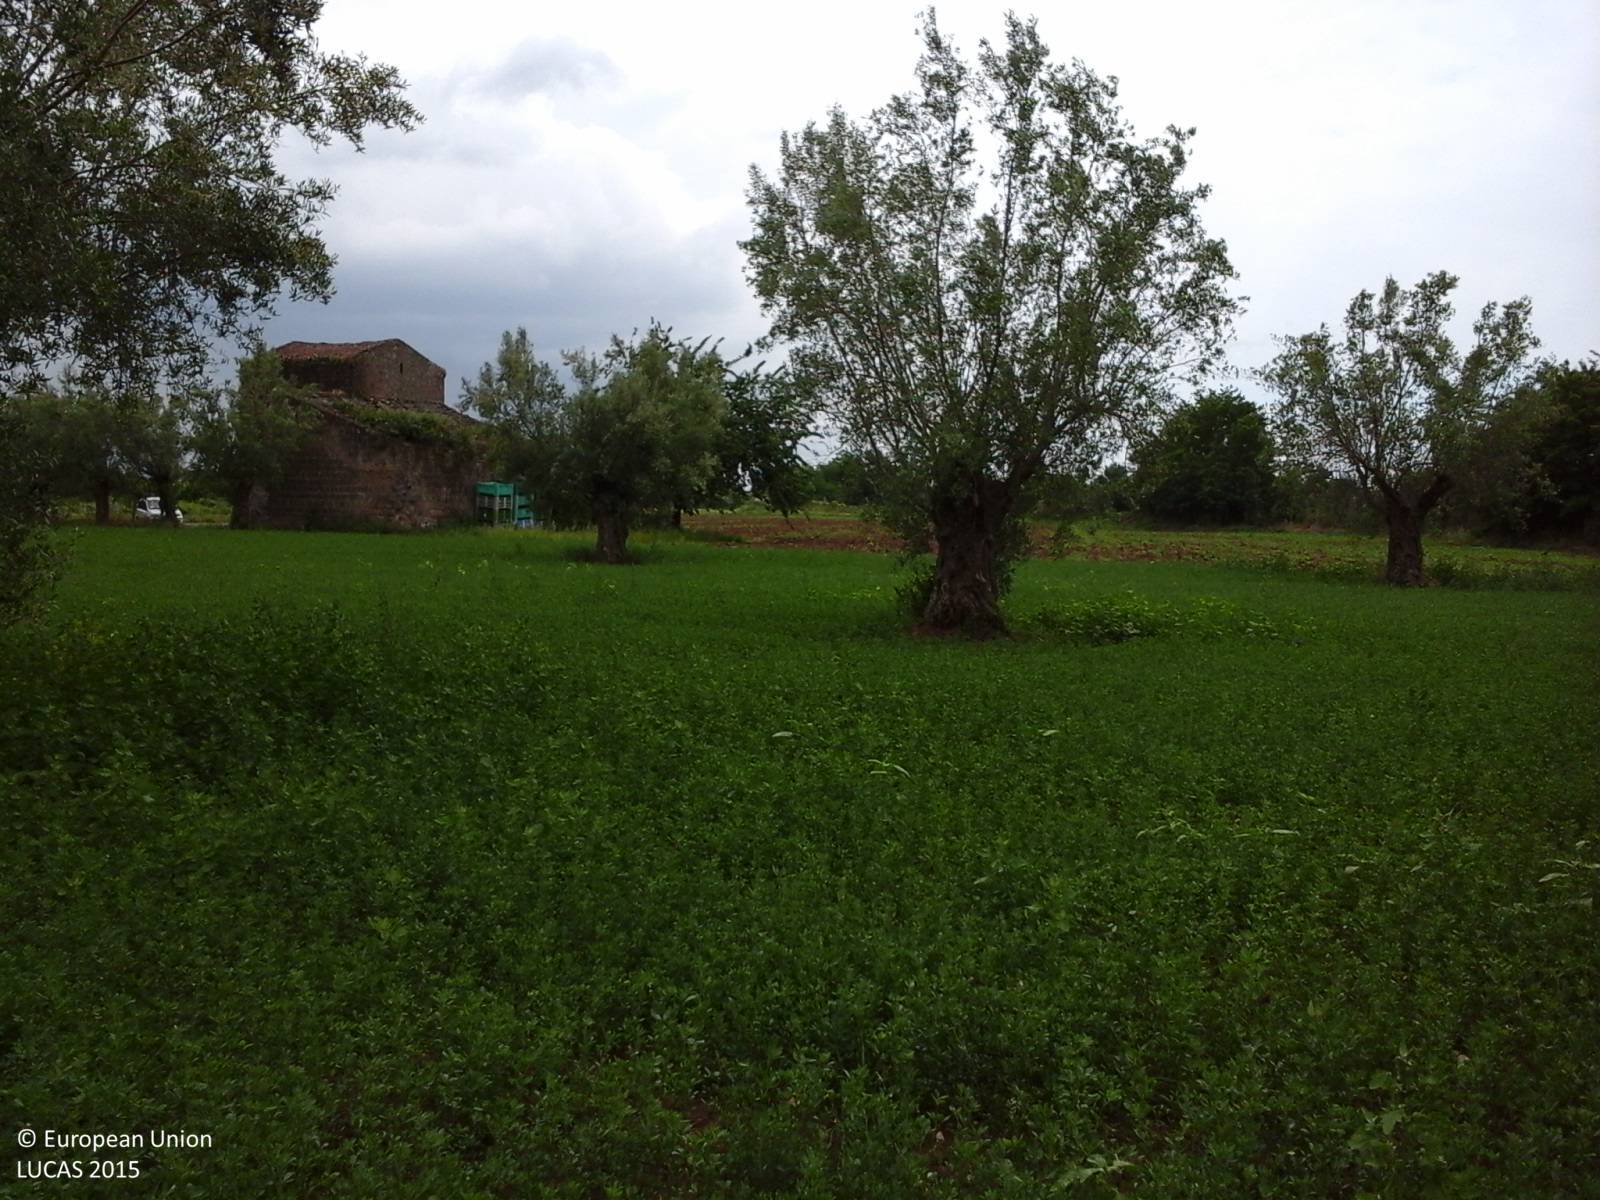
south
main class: Cropland
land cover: Lucerne
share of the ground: > 75 %
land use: Agriculture (excluding fallow land and kitchen gardens)
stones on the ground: < 10 %
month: May
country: IT
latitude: 41.1560
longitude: 14.1900
